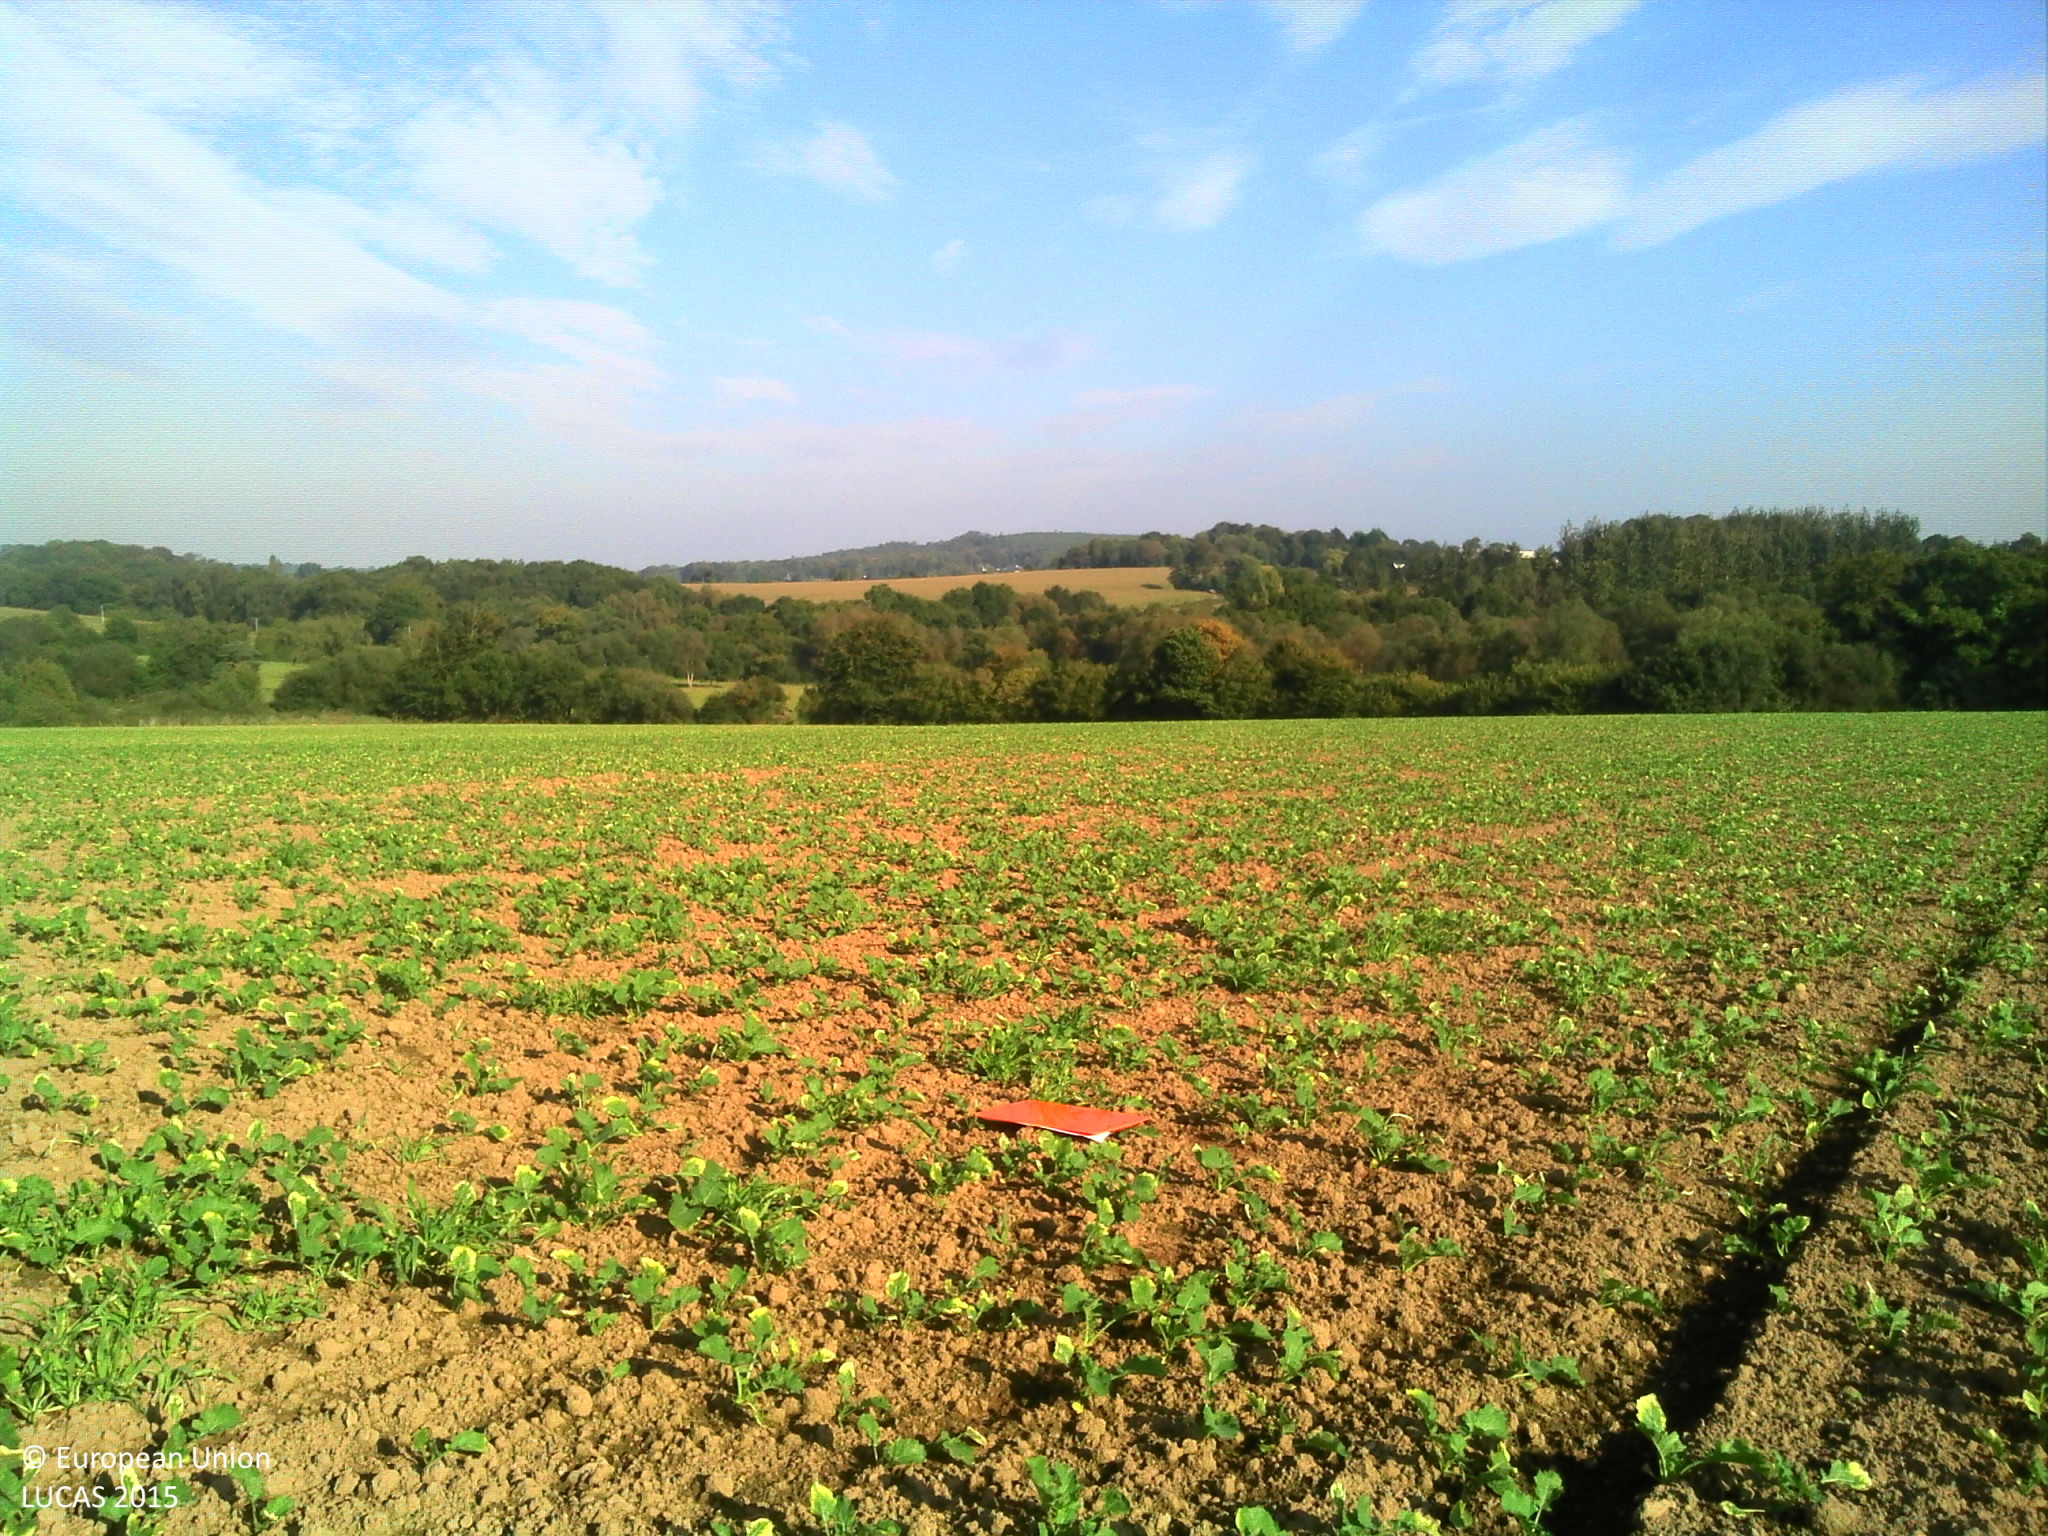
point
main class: Cropland
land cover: Rape and turnip rape
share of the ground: 25 - 50 %
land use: Agriculture (excluding fallow land and kitchen gardens)
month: October
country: FR
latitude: 48.4817
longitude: -3.2101
